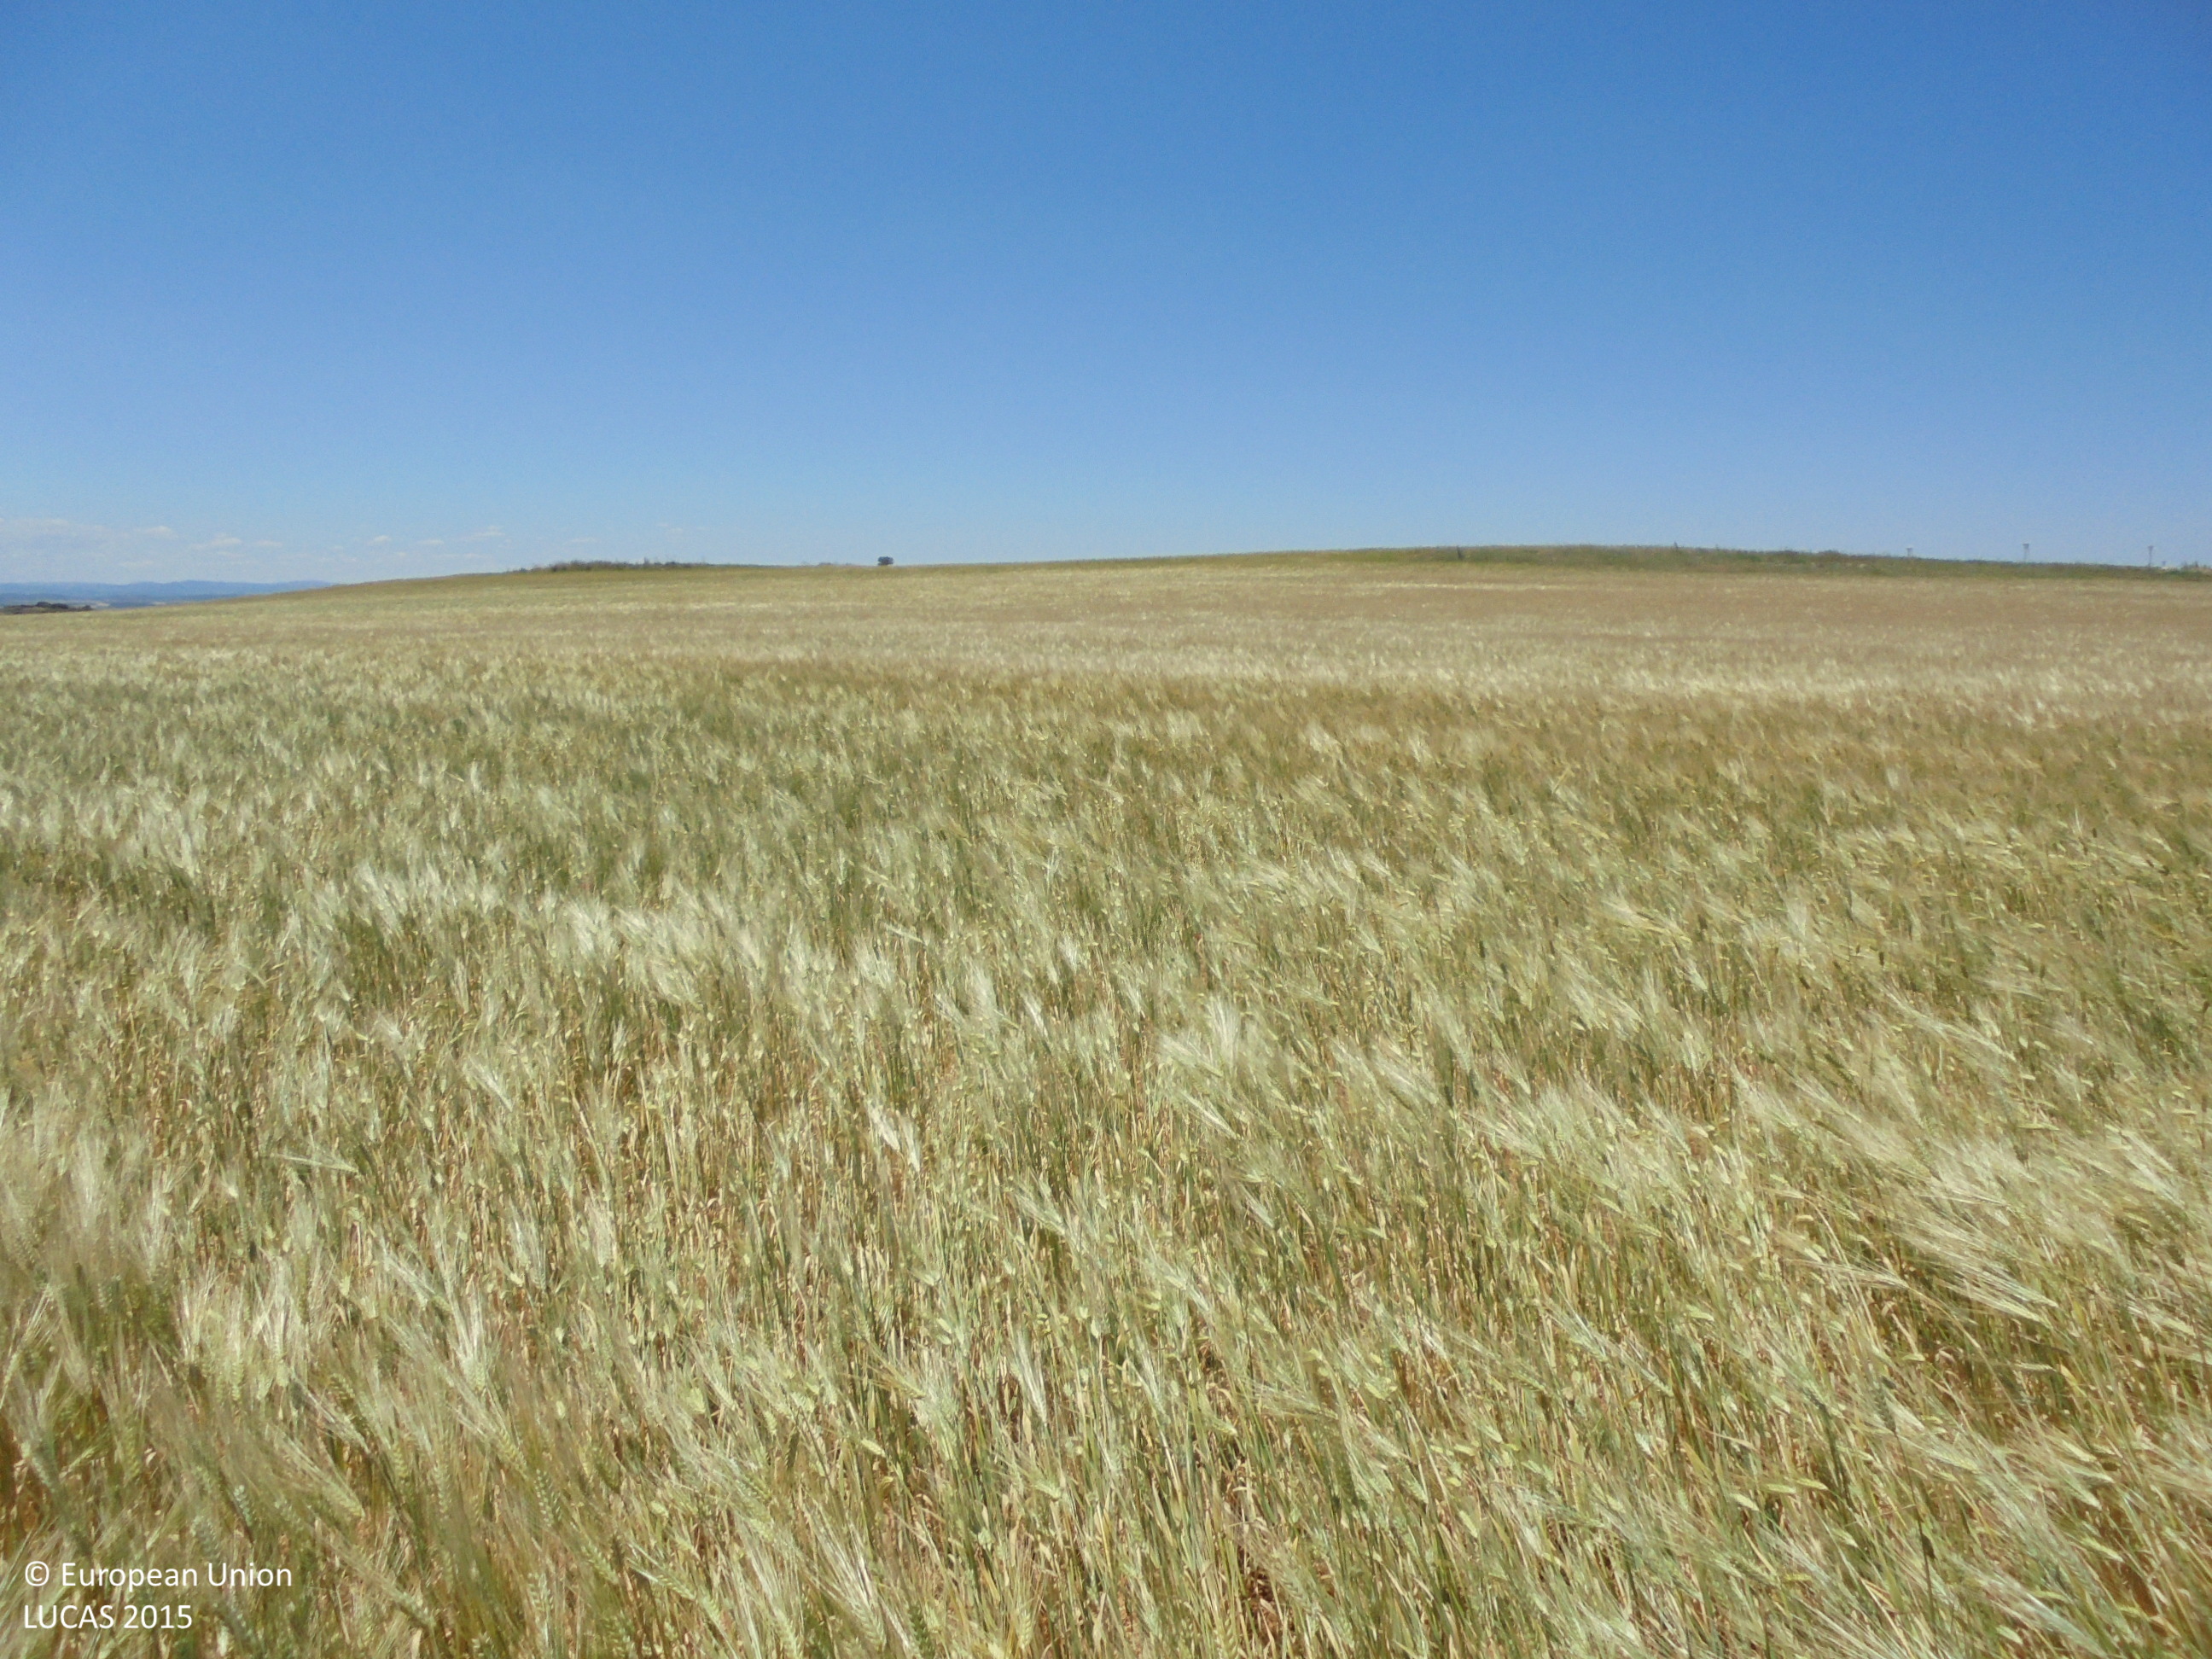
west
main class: Cropland
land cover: Barley
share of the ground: > 75 %
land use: Agriculture (excluding fallow land and kitchen gardens)
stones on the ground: < 10 %
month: May
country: ES
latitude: 38.8832
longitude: -1.7451
